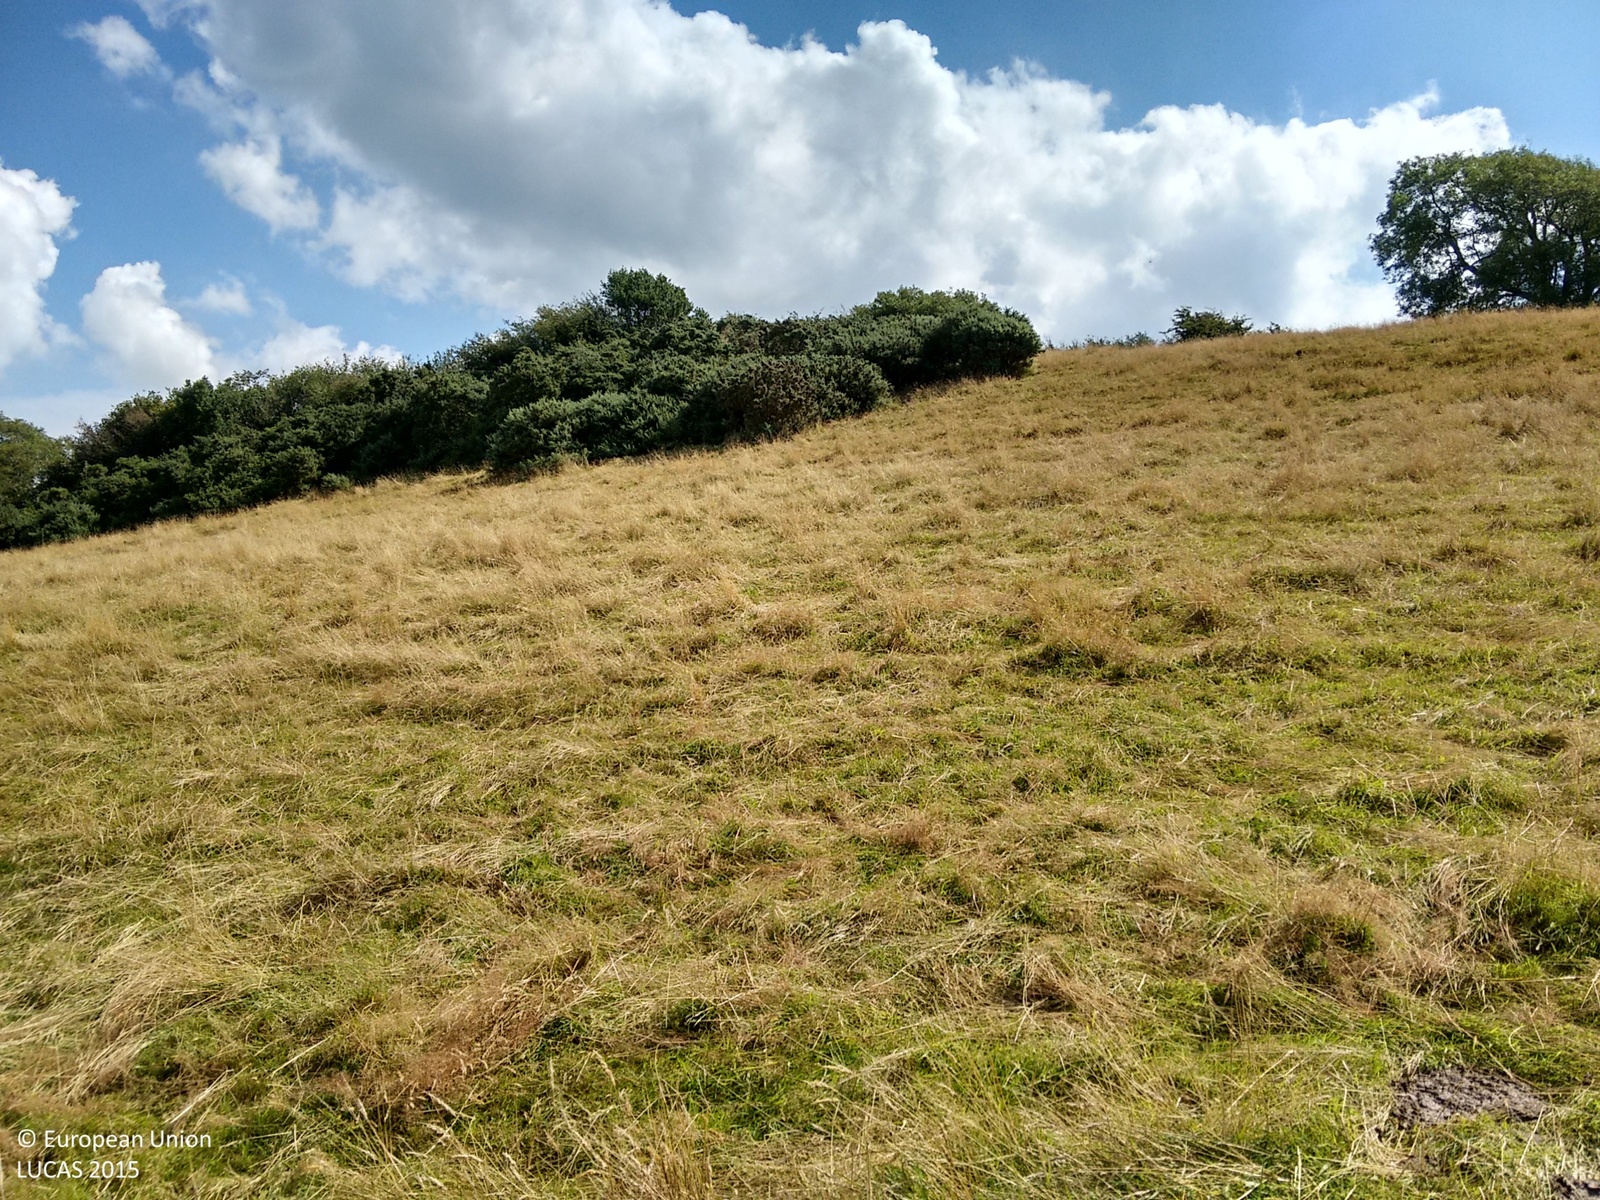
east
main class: Grassland
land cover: Grassland with sparse tree/shrub cover
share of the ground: > 75 %
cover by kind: herbaceous plants 95 %, broadleaved forest trees 5 %
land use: Agriculture (excluding fallow land and kitchen gardens)
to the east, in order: Grassland with sparse tree/shrub cover; Grassland without tree/shrub cover; Shrubland without tree cover; Abandoned hedges; Grassland without tree/shrub cover
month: August
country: GB
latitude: 51.7878
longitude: -4.3826
